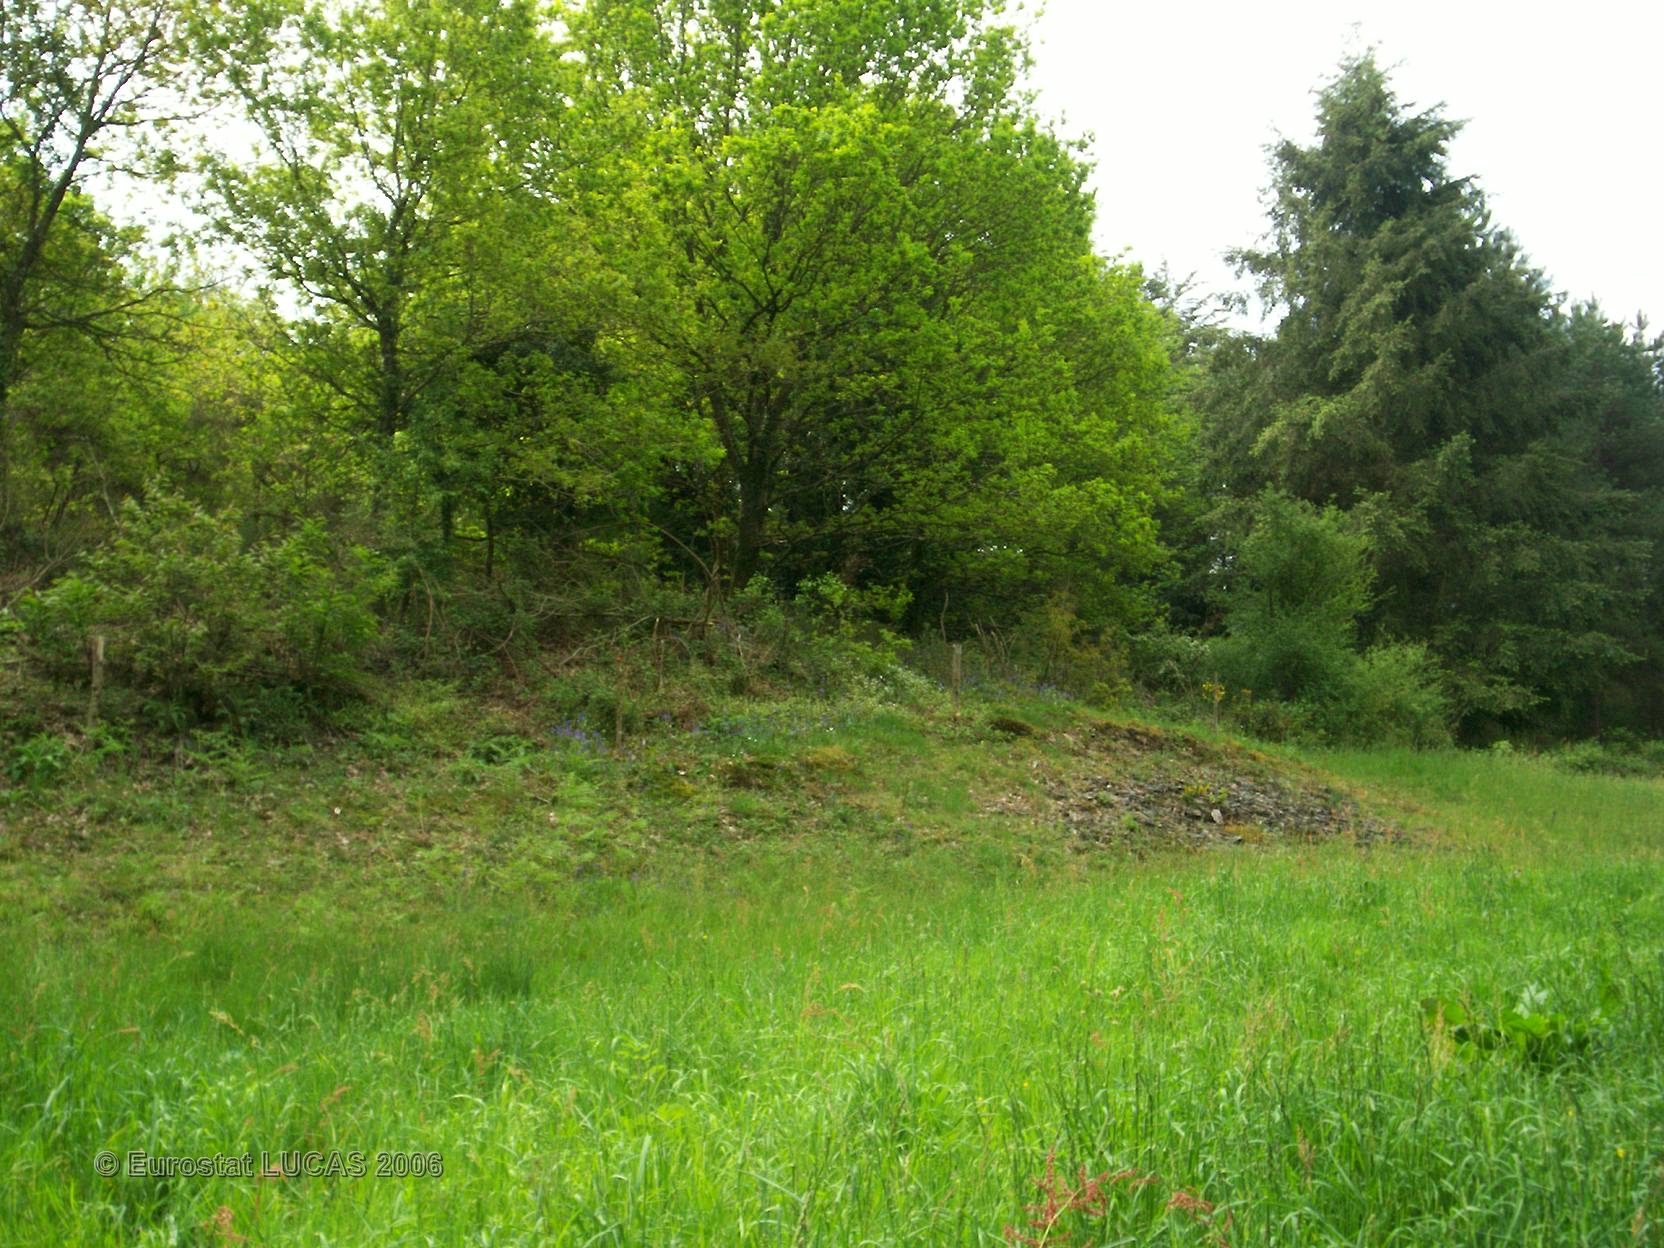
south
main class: Grassland
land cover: Grassland without tree/shrub cover
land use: Unused
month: May
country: FR
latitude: 47.7840
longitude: -2.3218
